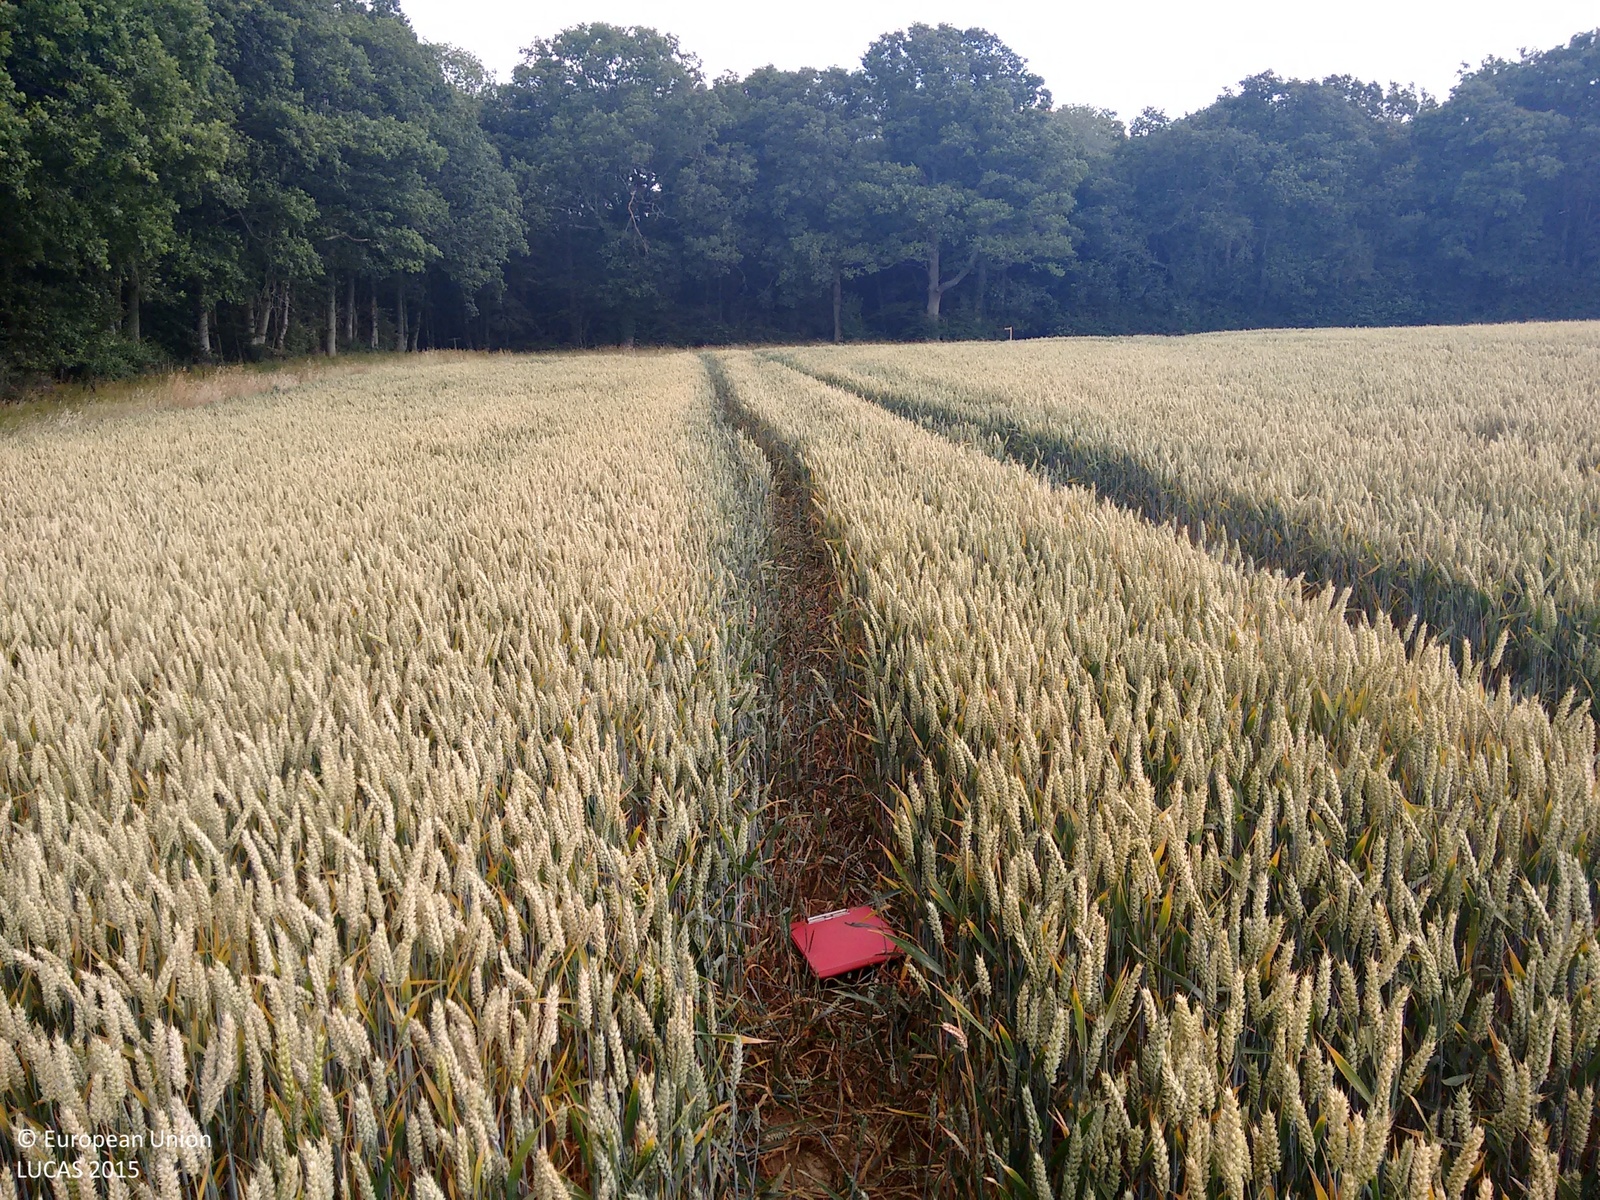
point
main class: Cropland
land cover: Common wheat
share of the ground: 50 - 75 %
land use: Agriculture (excluding fallow land and kitchen gardens)
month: July
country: GB
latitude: 51.0585
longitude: -0.4965
